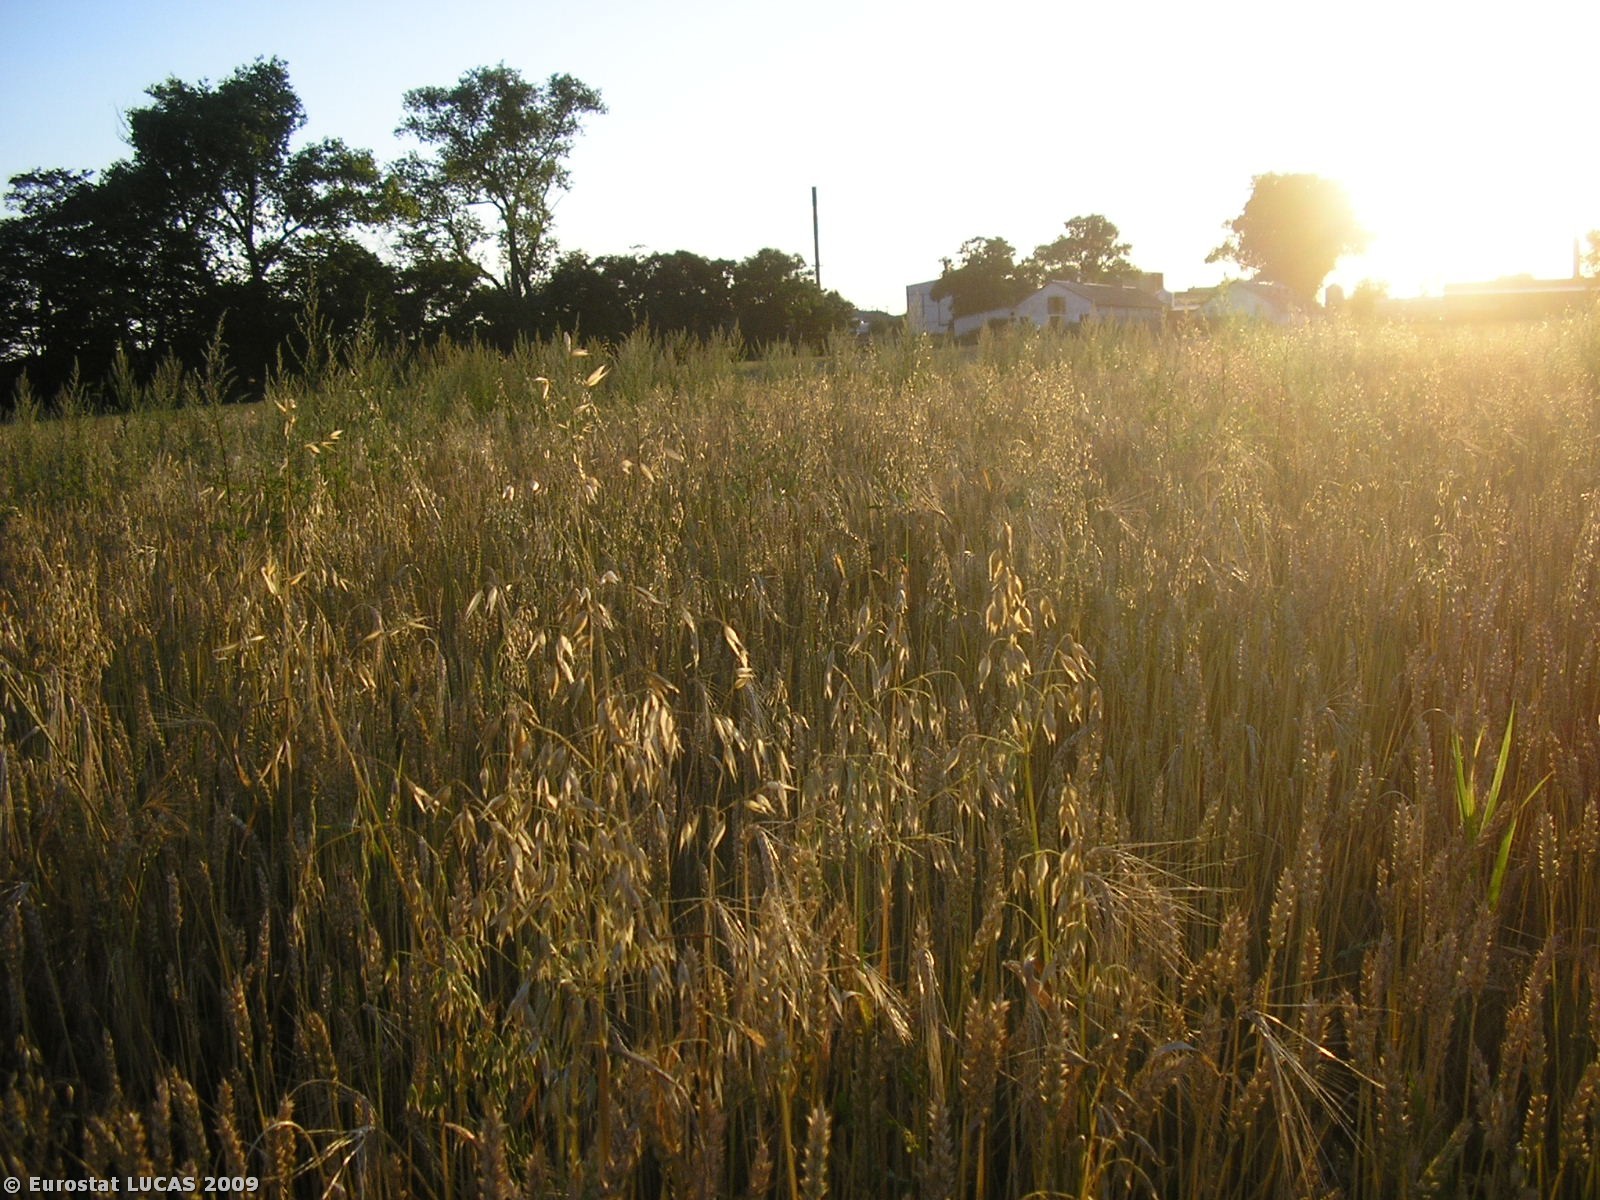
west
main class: Cropland
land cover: Mixed cereals for fodder
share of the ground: > 75 %
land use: Agriculture (excluding fallow land and kitchen gardens)
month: July
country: PL
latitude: 52.3895
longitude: 22.3031
